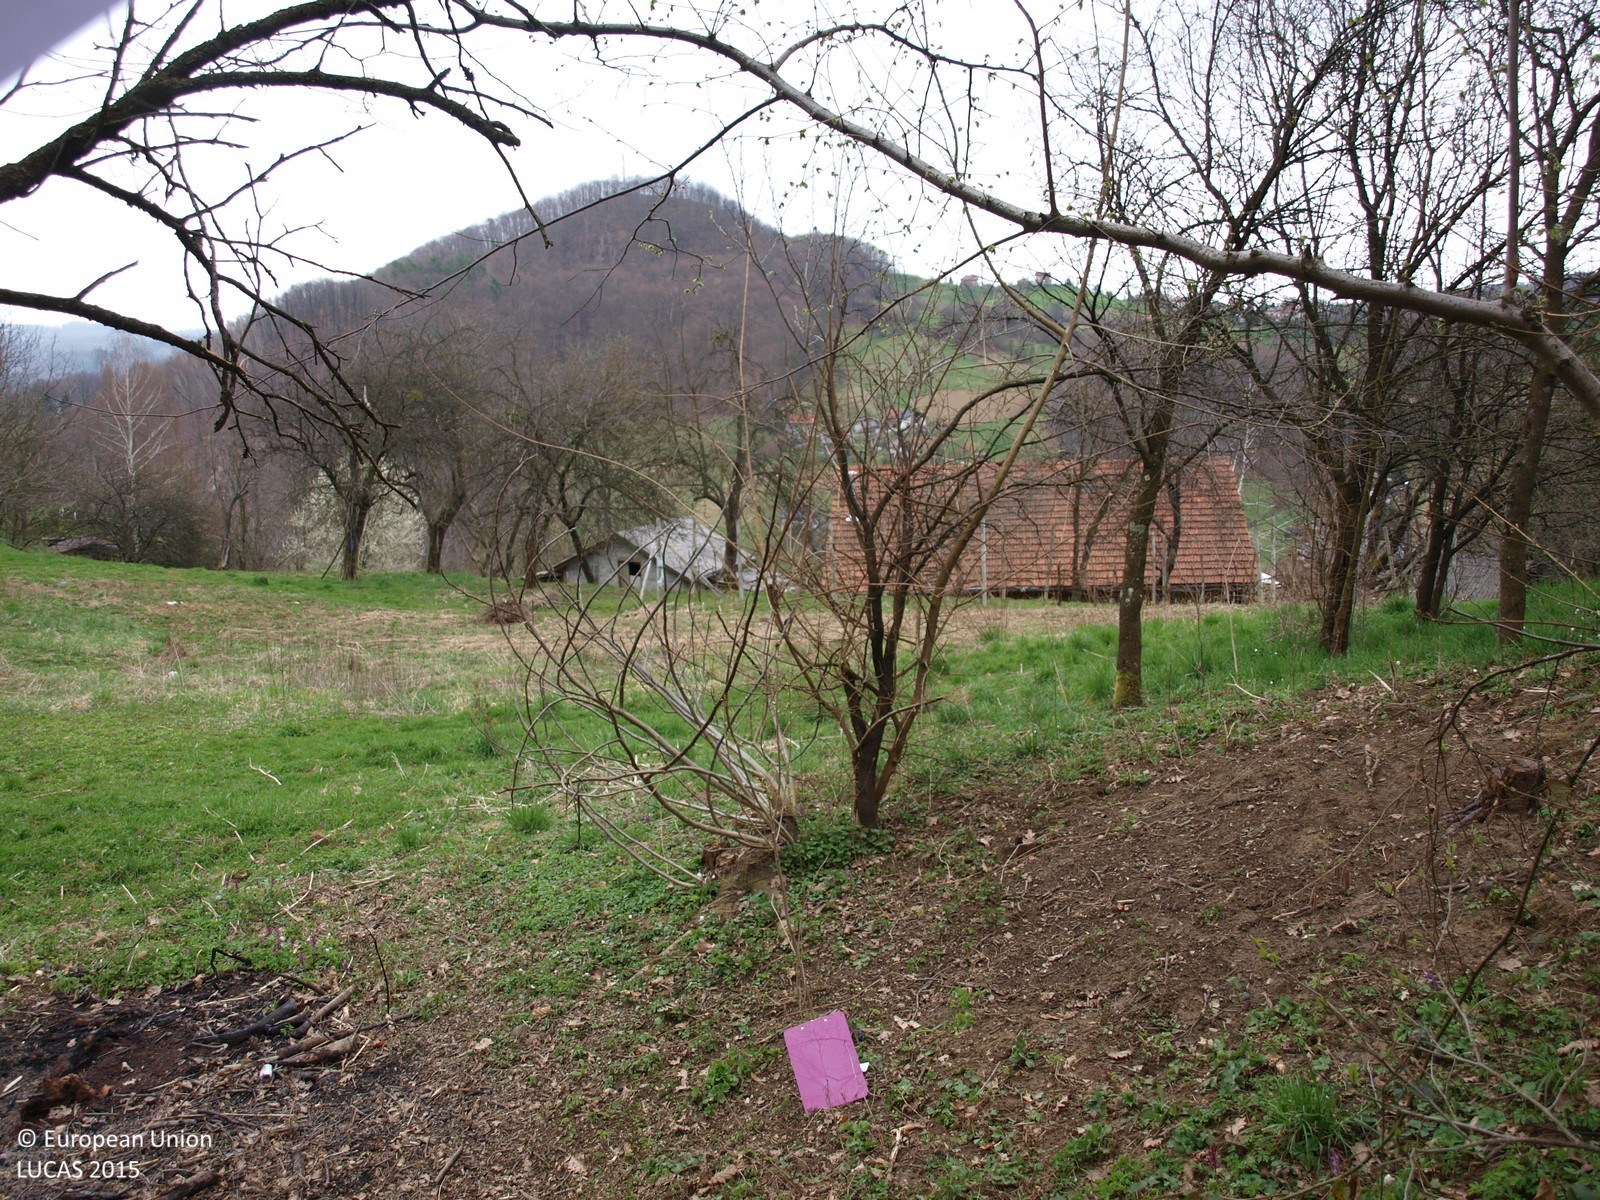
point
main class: Cropland
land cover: Other fruit trees and berries
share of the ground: > 75 %
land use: Agriculture (excluding fallow land and kitchen gardens)
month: April
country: HR
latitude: 46.2178
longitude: 15.6893
